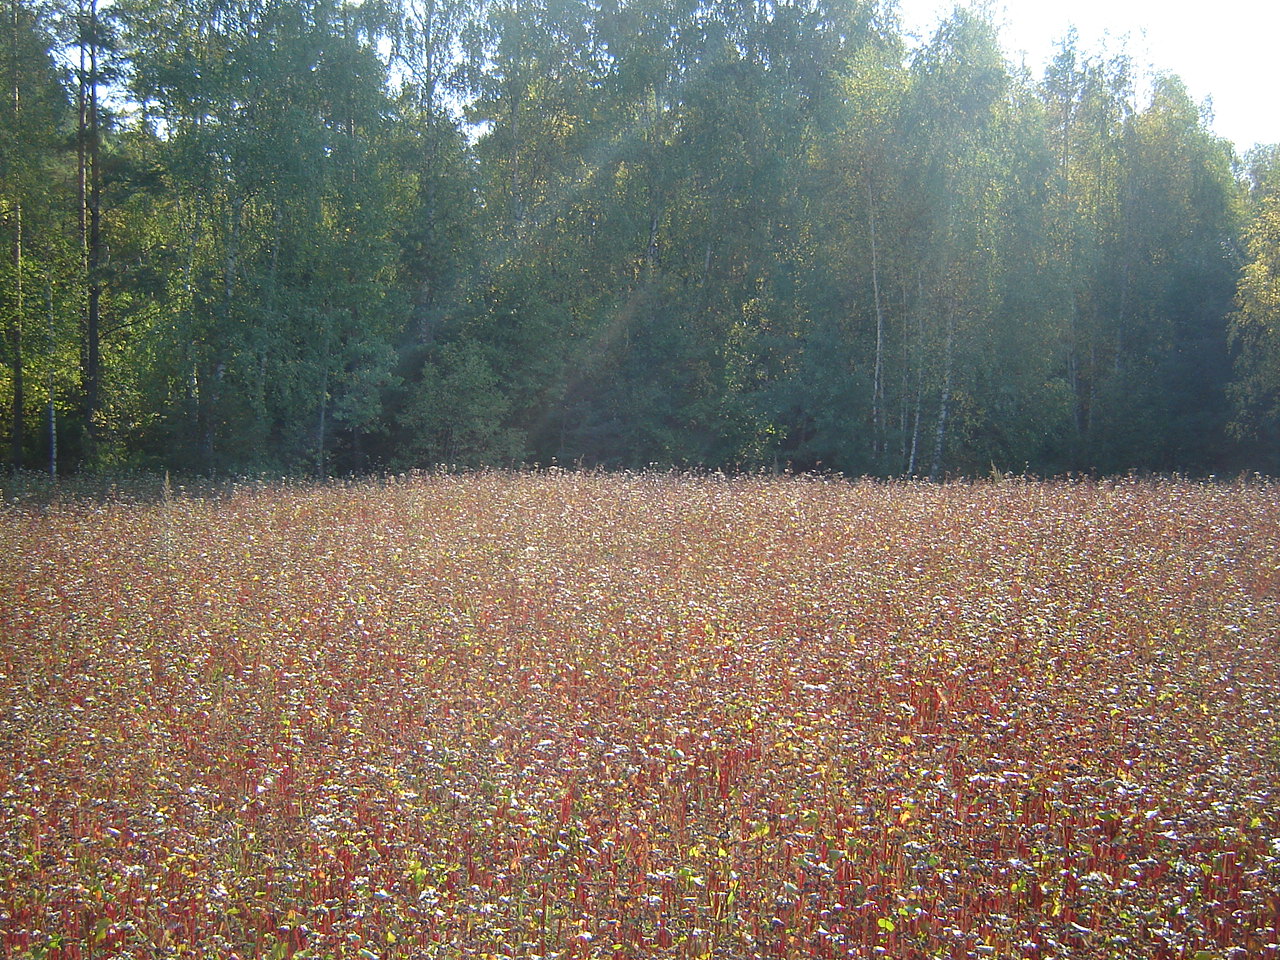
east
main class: Cropland
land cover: Other cereals
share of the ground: > 75 %
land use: Agriculture (excluding fallow land and kitchen gardens)
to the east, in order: Other cereals; Grass margins; Tracks; Broadleaved woodland; Other mixed woodland; Pine dominated mixed woodland
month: August
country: LT
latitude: 54.5796
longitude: 24.8872
